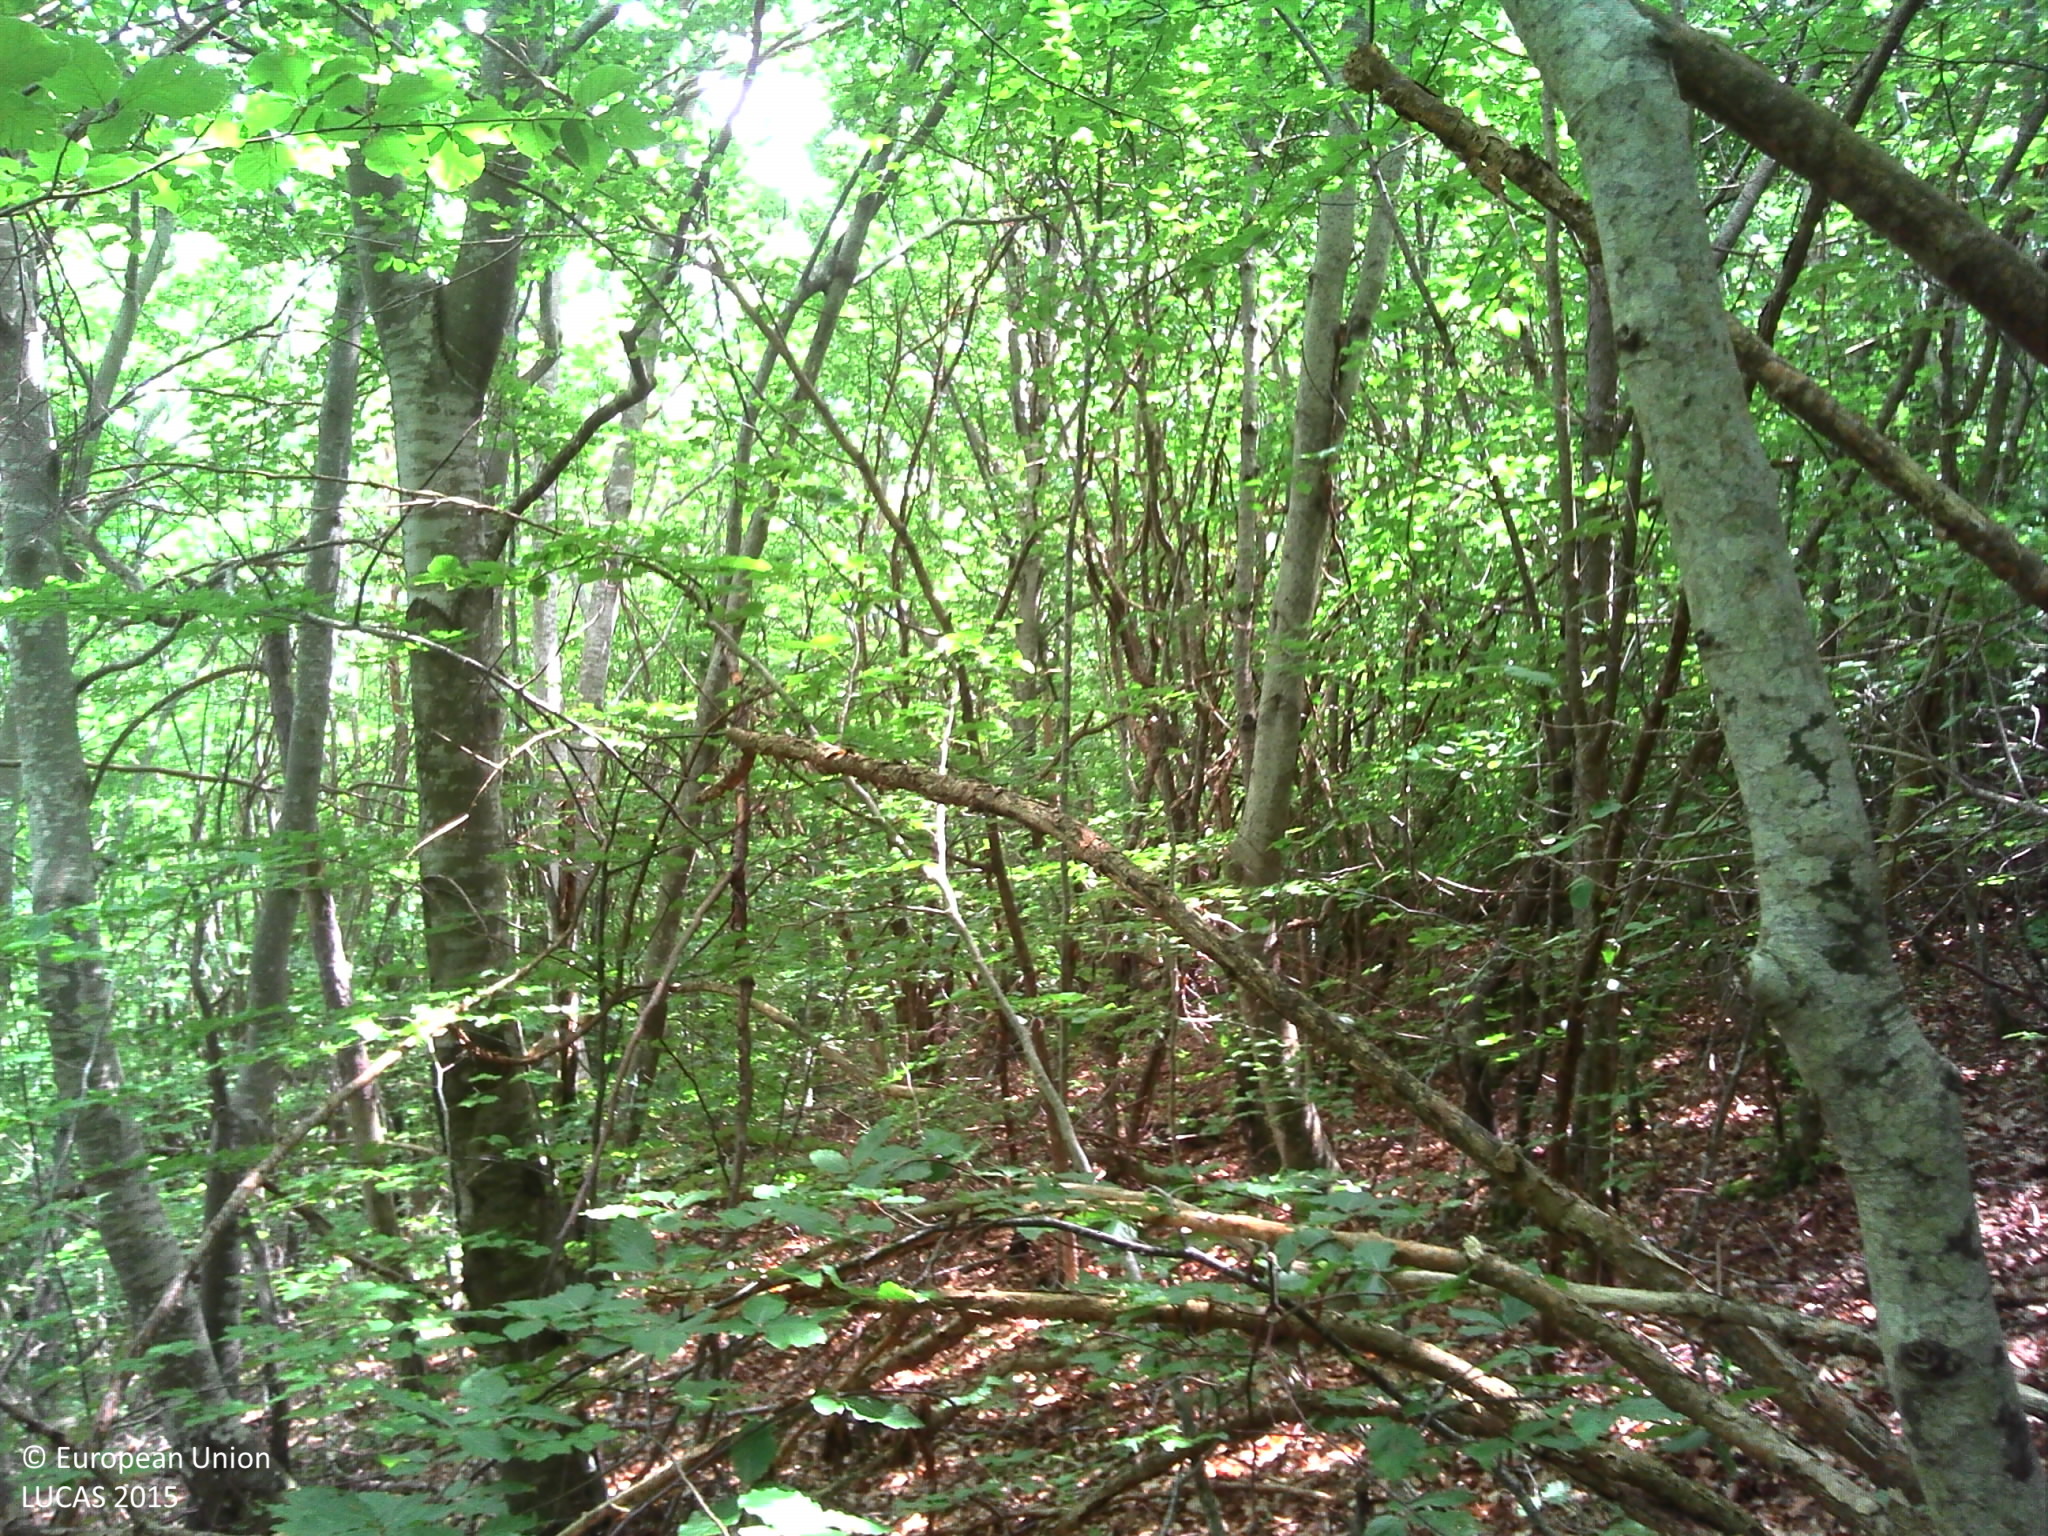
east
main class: Woodland
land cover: Broadleaved woodland
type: beech forest
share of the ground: > 75 %
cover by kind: broadleaved forest trees 95 %, lichens and mosses 5 %
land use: Forestry
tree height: > 5 m
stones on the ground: < 10 %
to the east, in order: Broadleaved woodland; Pine dominated coniferous woodland; Ditches and canals
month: June
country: FR
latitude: 44.6551
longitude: 5.2020
